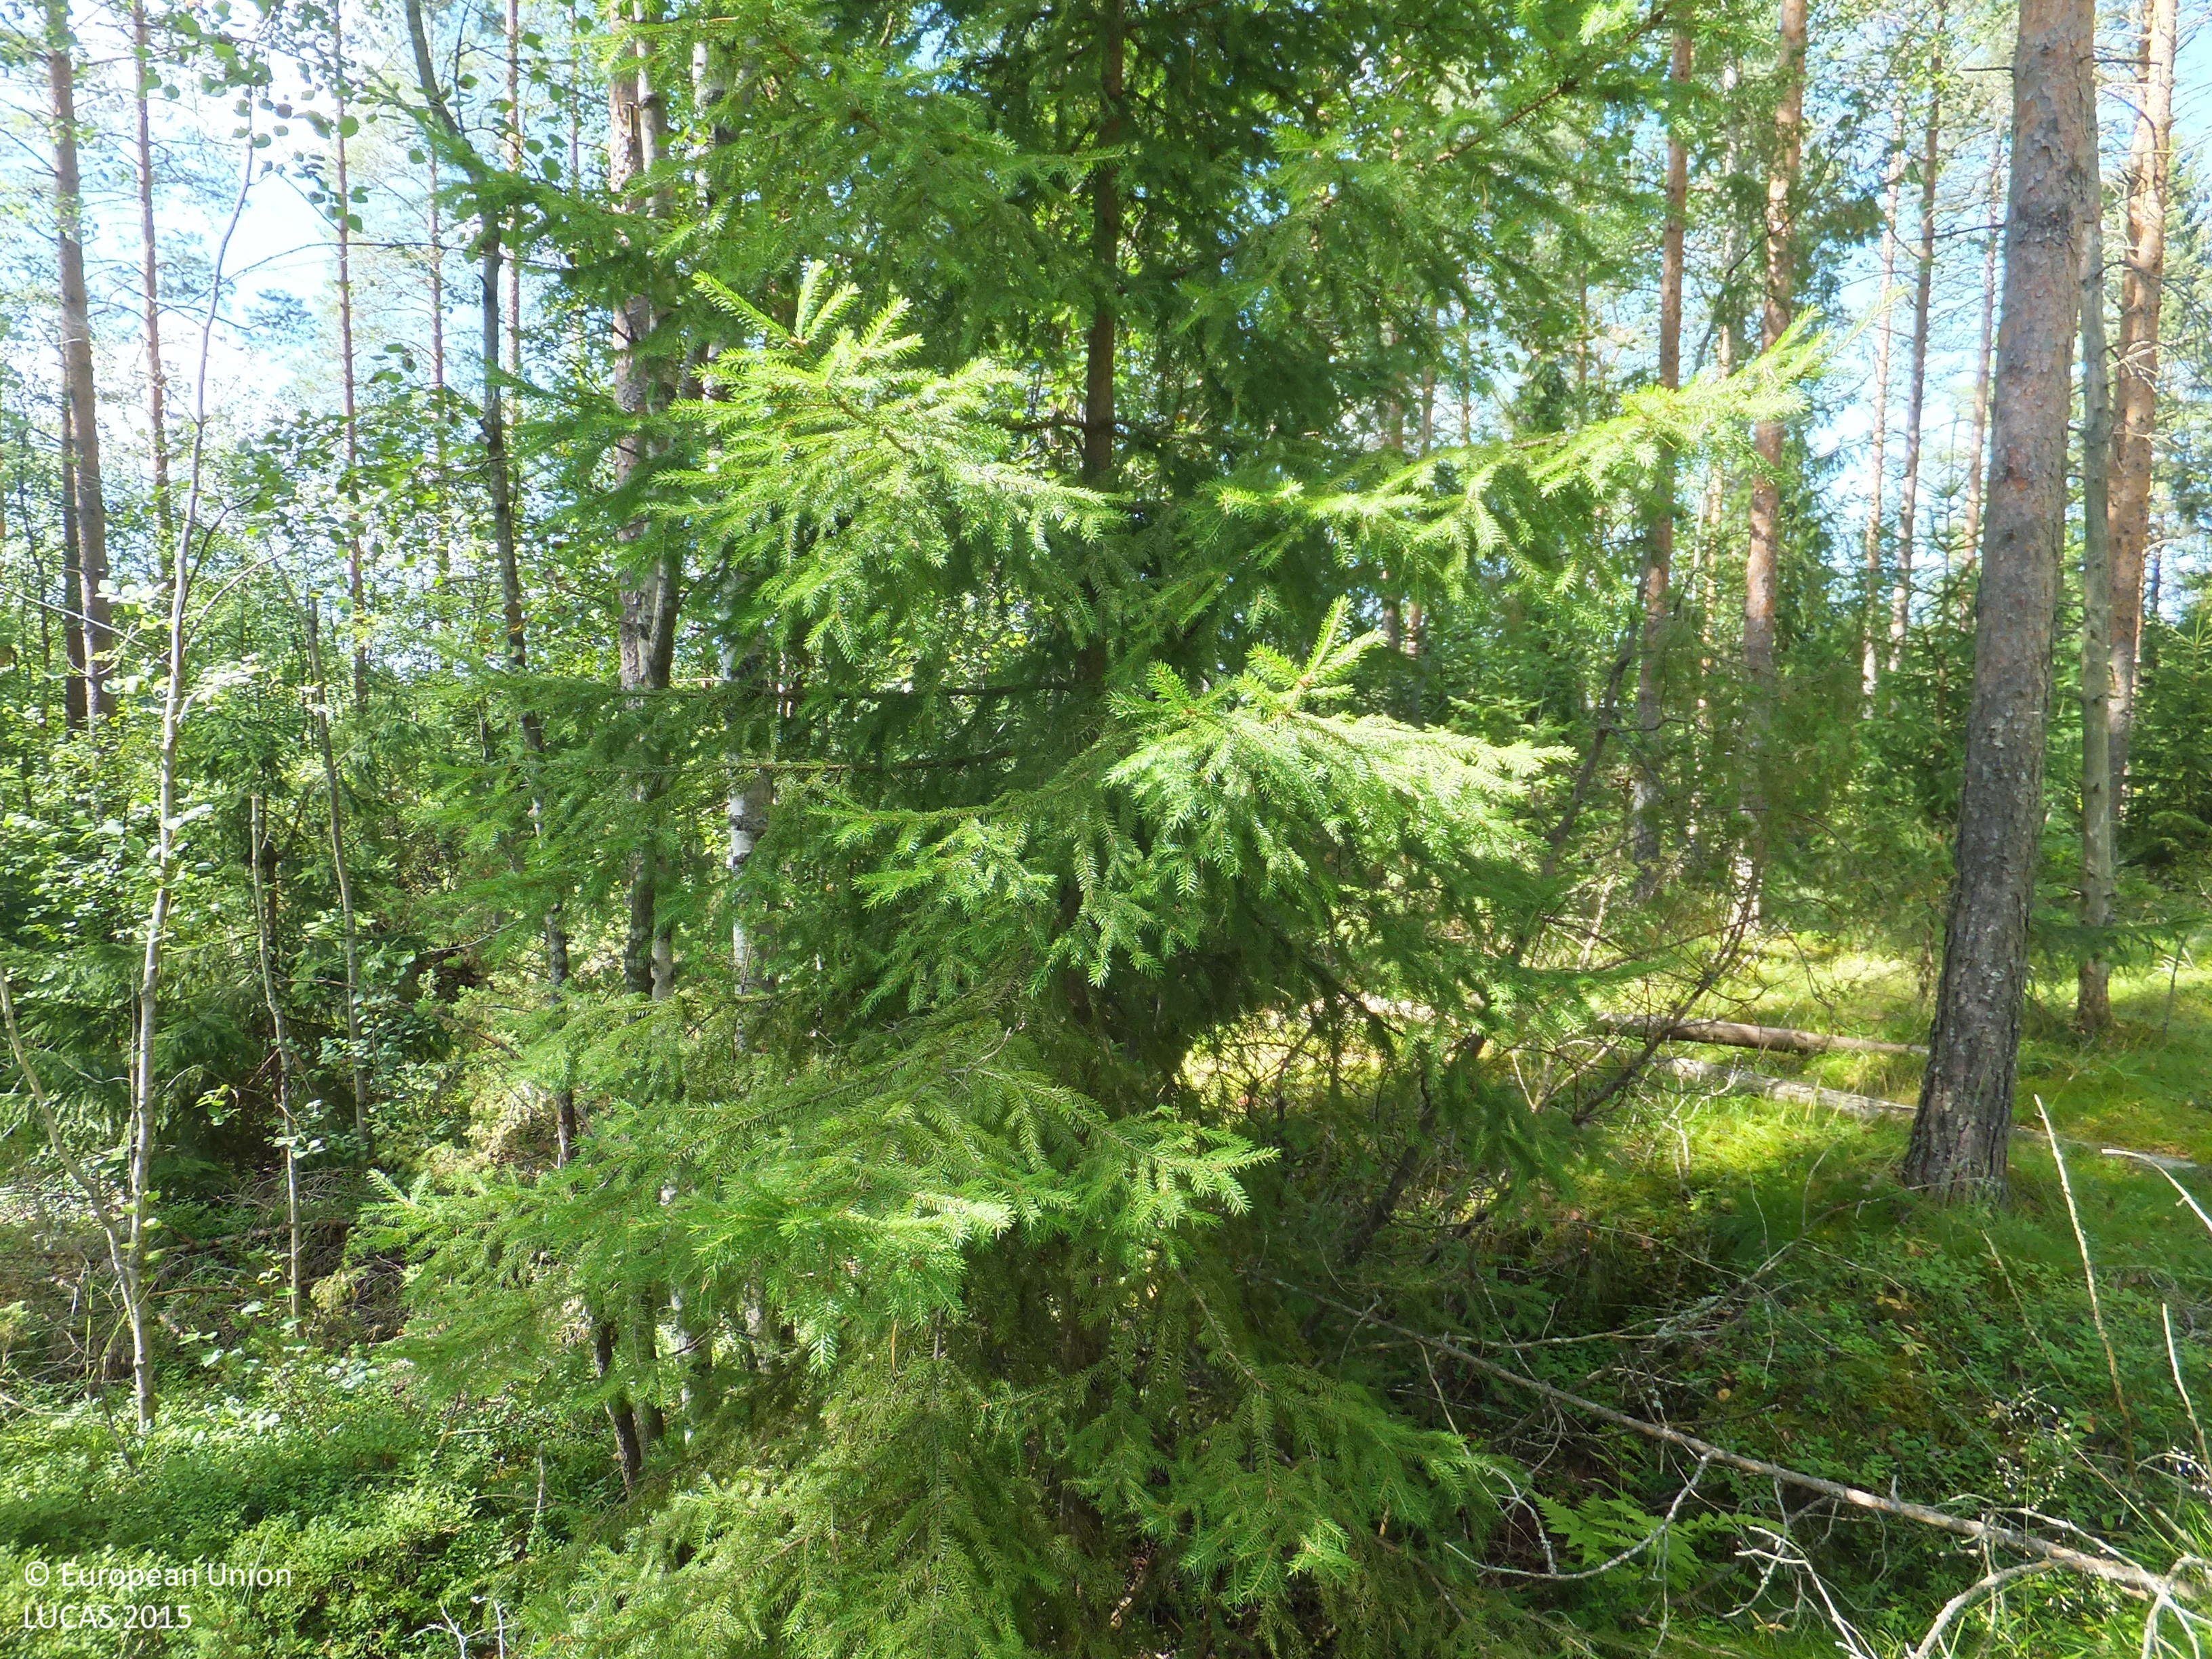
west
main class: Woodland
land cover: Pine dominated mixed woodland
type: boreal forest
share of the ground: 50 - 75 %
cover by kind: coniferous forest trees 40 %, shrubs 20 %, broadleaved forest trees 15 %, herbaceous plants 10 %, lichens and mosses 10 %, consolidated bare surface 5 %
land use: Forestry
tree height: > 5 m
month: August
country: FI
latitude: 63.0788
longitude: 22.7040
